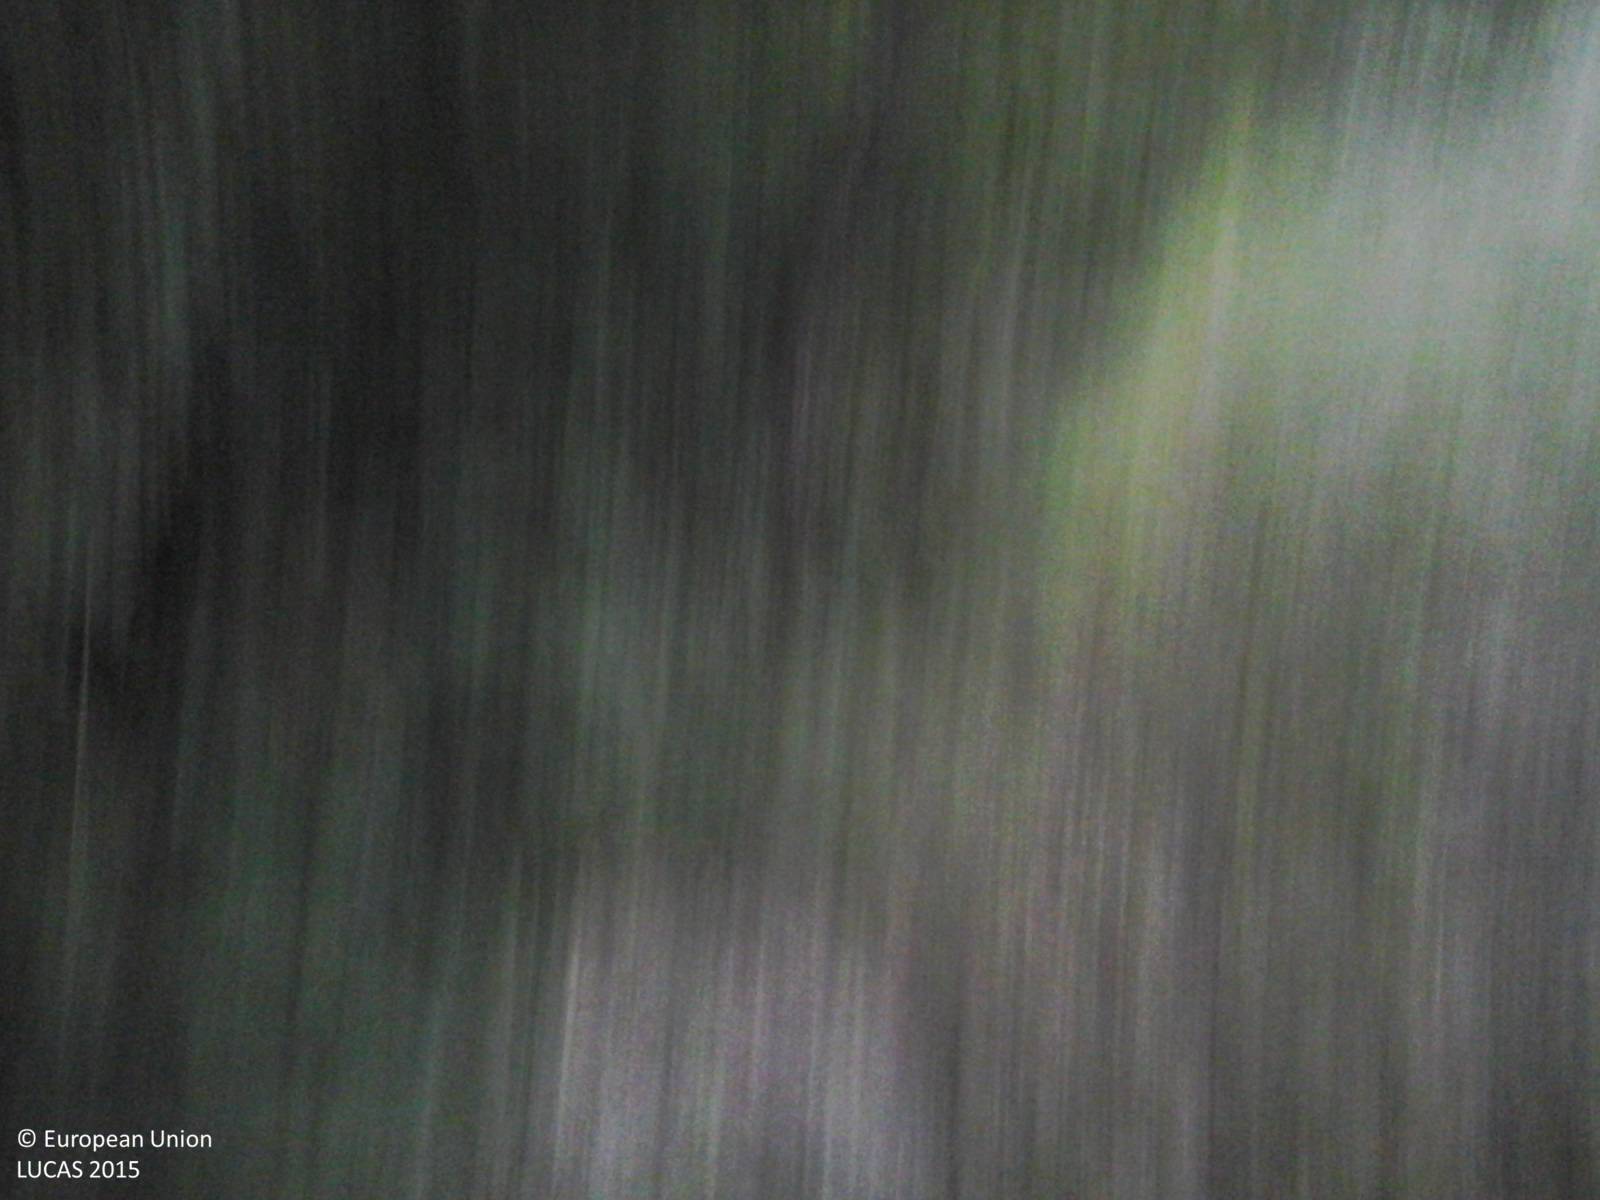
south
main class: Woodland
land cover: Broadleaved woodland
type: thermophilous deciduous forest
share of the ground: > 75 %
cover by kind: broadleaved forest trees 95 %, shrubs 5 %
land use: Semi-natural and natural areas not in use
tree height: > 5 m
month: October
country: IT
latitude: 42.2541
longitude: 12.7904
